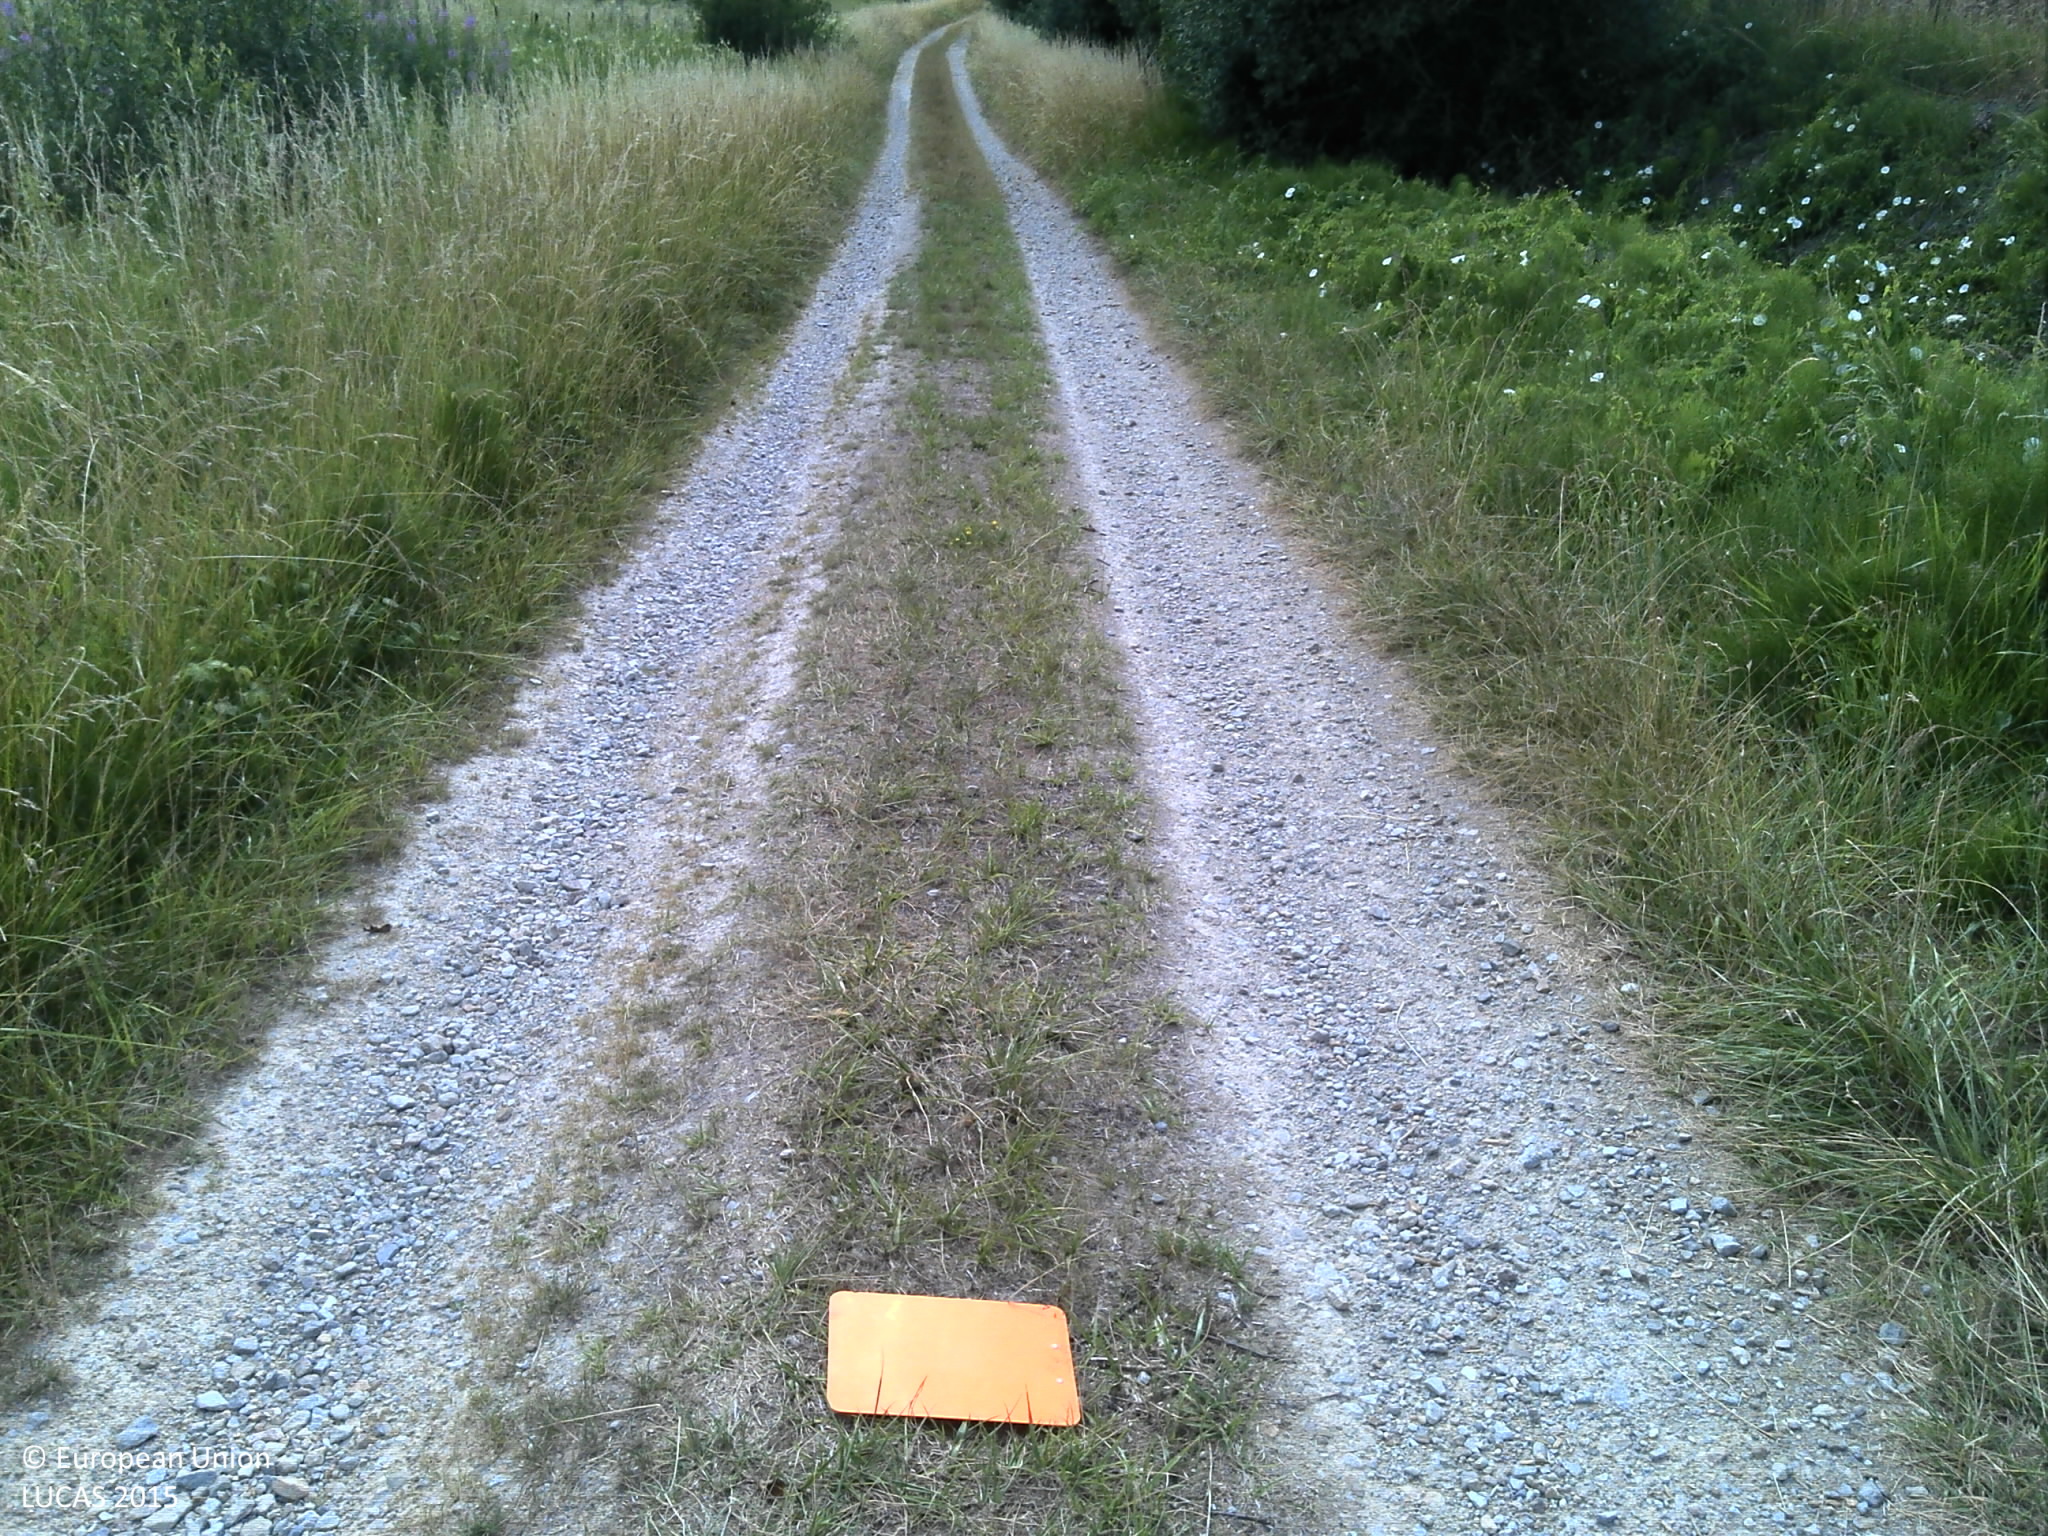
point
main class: Artificial land
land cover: Non built-up linear features
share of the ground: > 75 %
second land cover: Spontaneously vegetated surfaces
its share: 25 - 50 %
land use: Road transport
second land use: Agriculture (excluding fallow land and kitchen gardens)
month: July
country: FR
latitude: 49.6422
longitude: 4.6095
